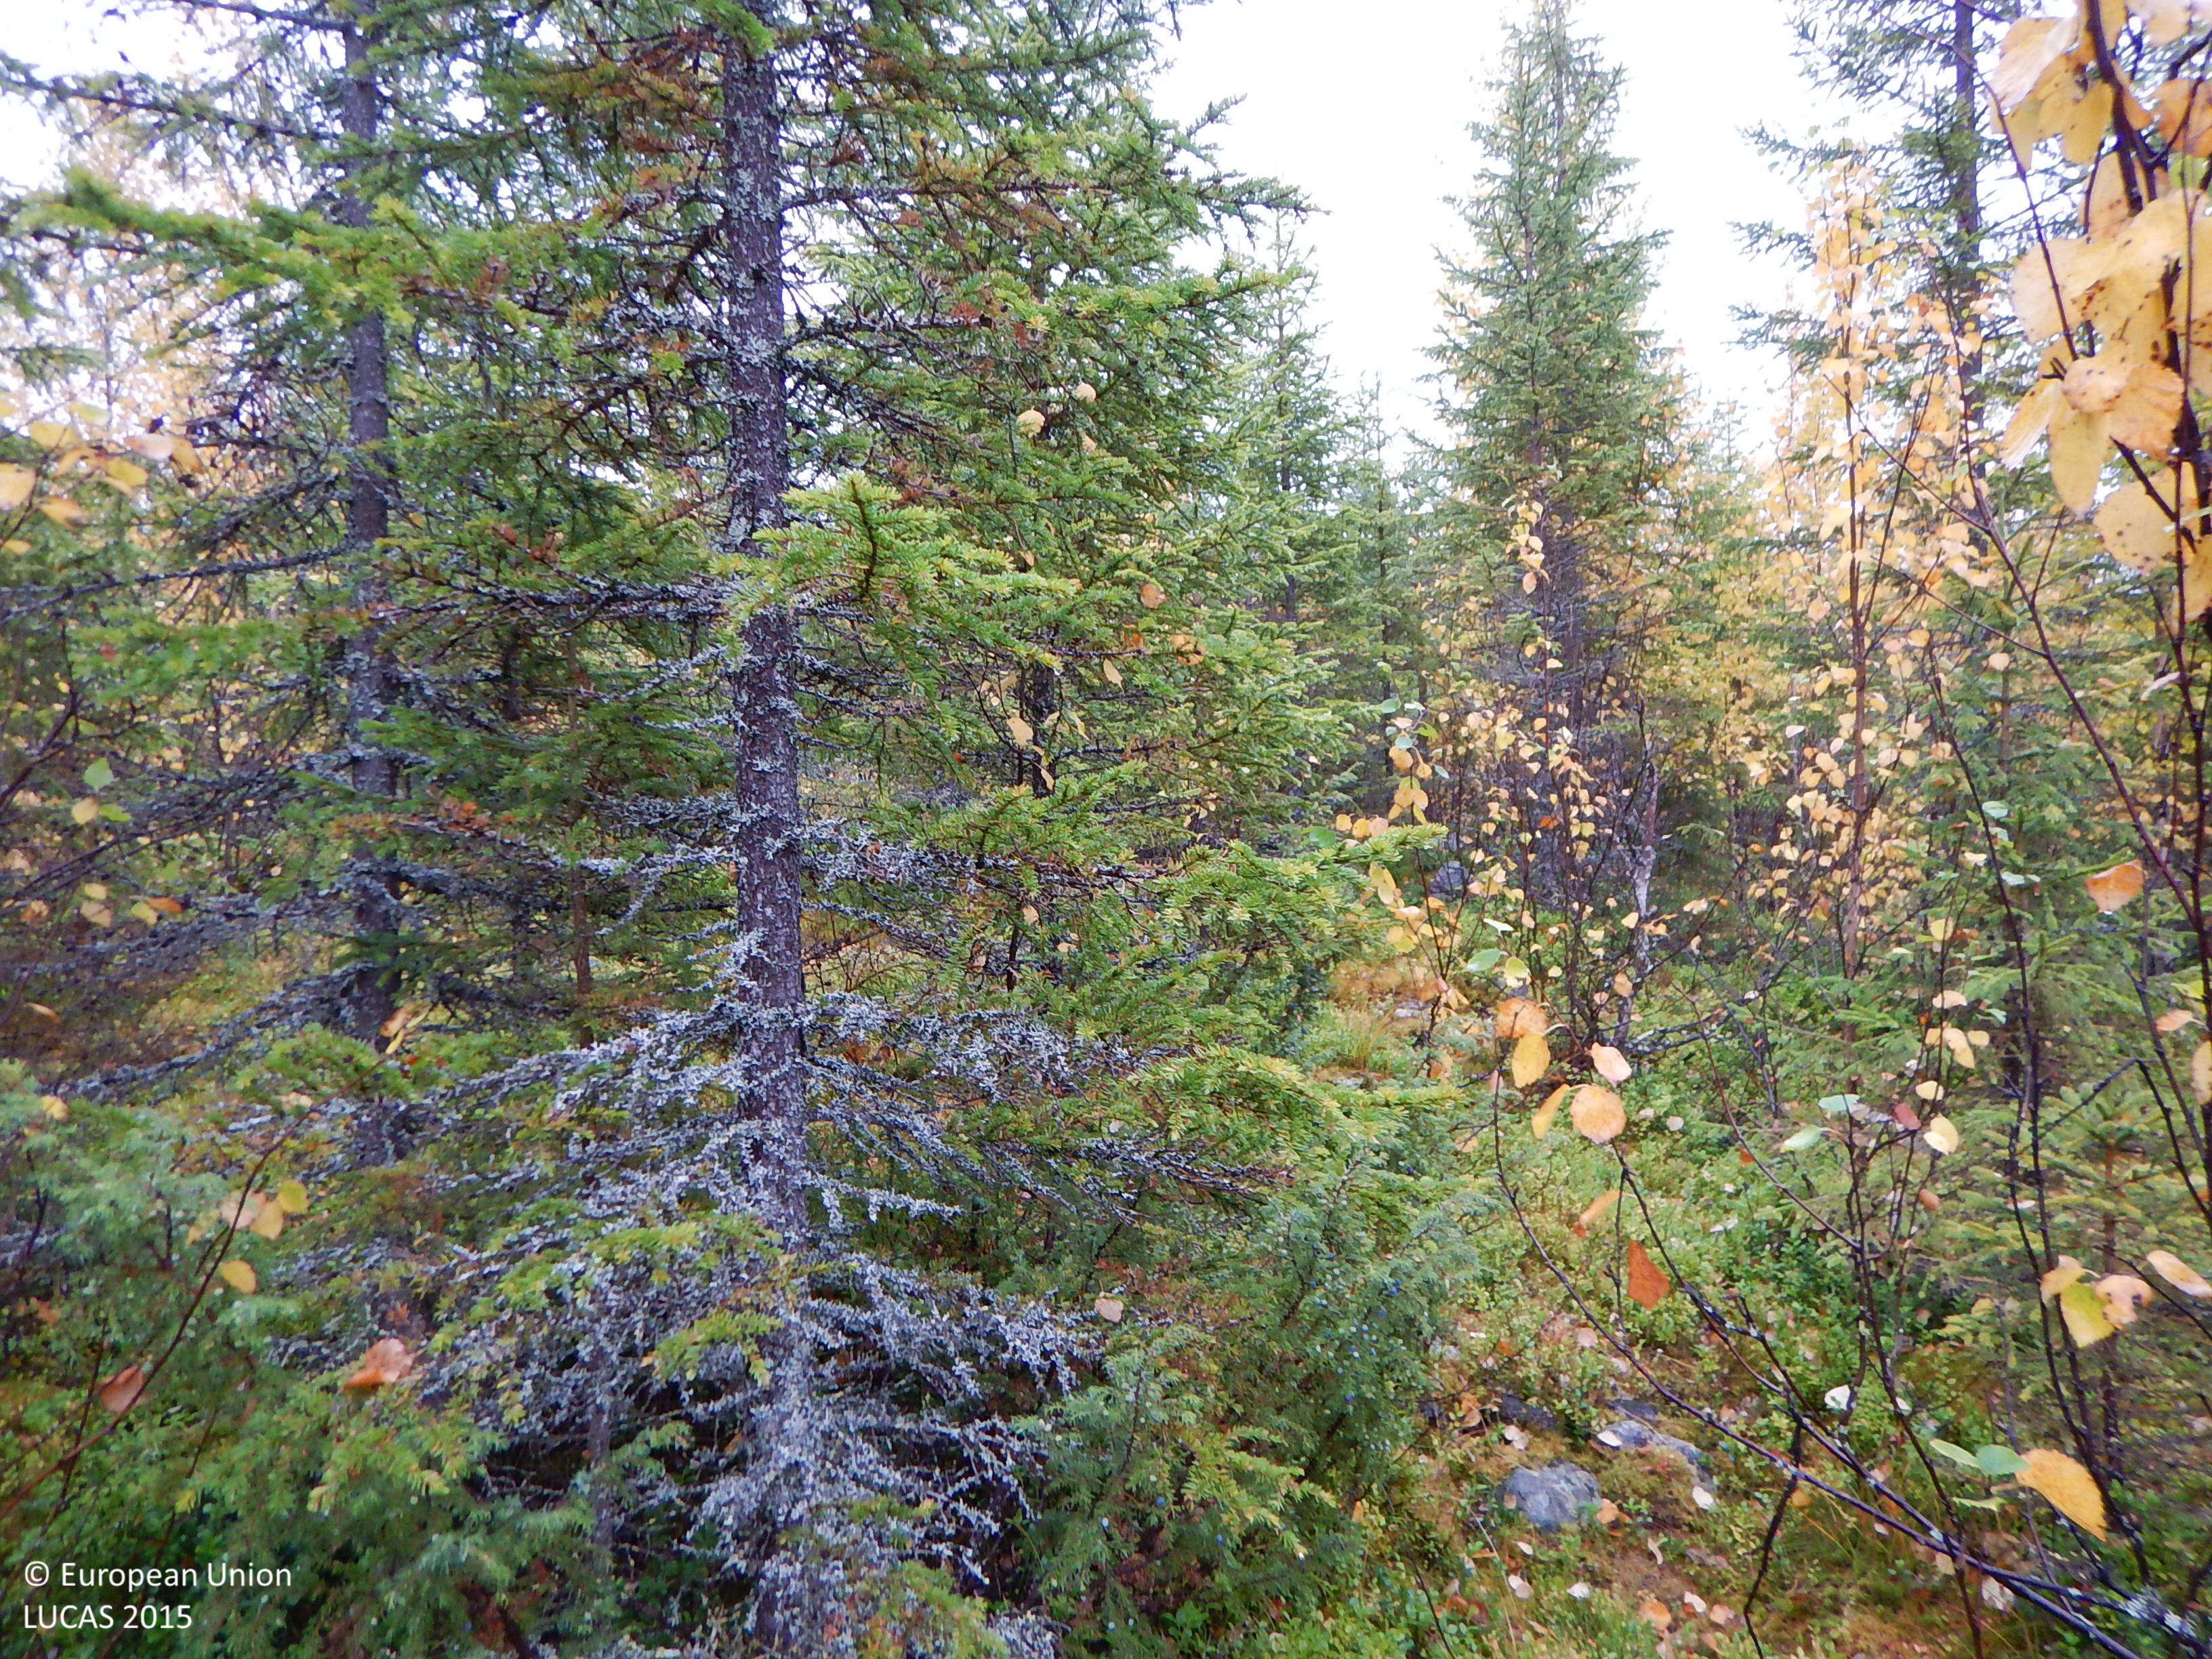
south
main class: Woodland
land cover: Spruce dominated coniferous woodland
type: boreal forest
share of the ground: 50 - 75 %
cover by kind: coniferous forest trees 55 %, lichens and mosses 20 %, shrubs 15 %, broadleaved forest trees 5 %, herbaceous plants 5 %
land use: Forestry
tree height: < 5 m
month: September
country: SE
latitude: 65.0371
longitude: 18.9478
